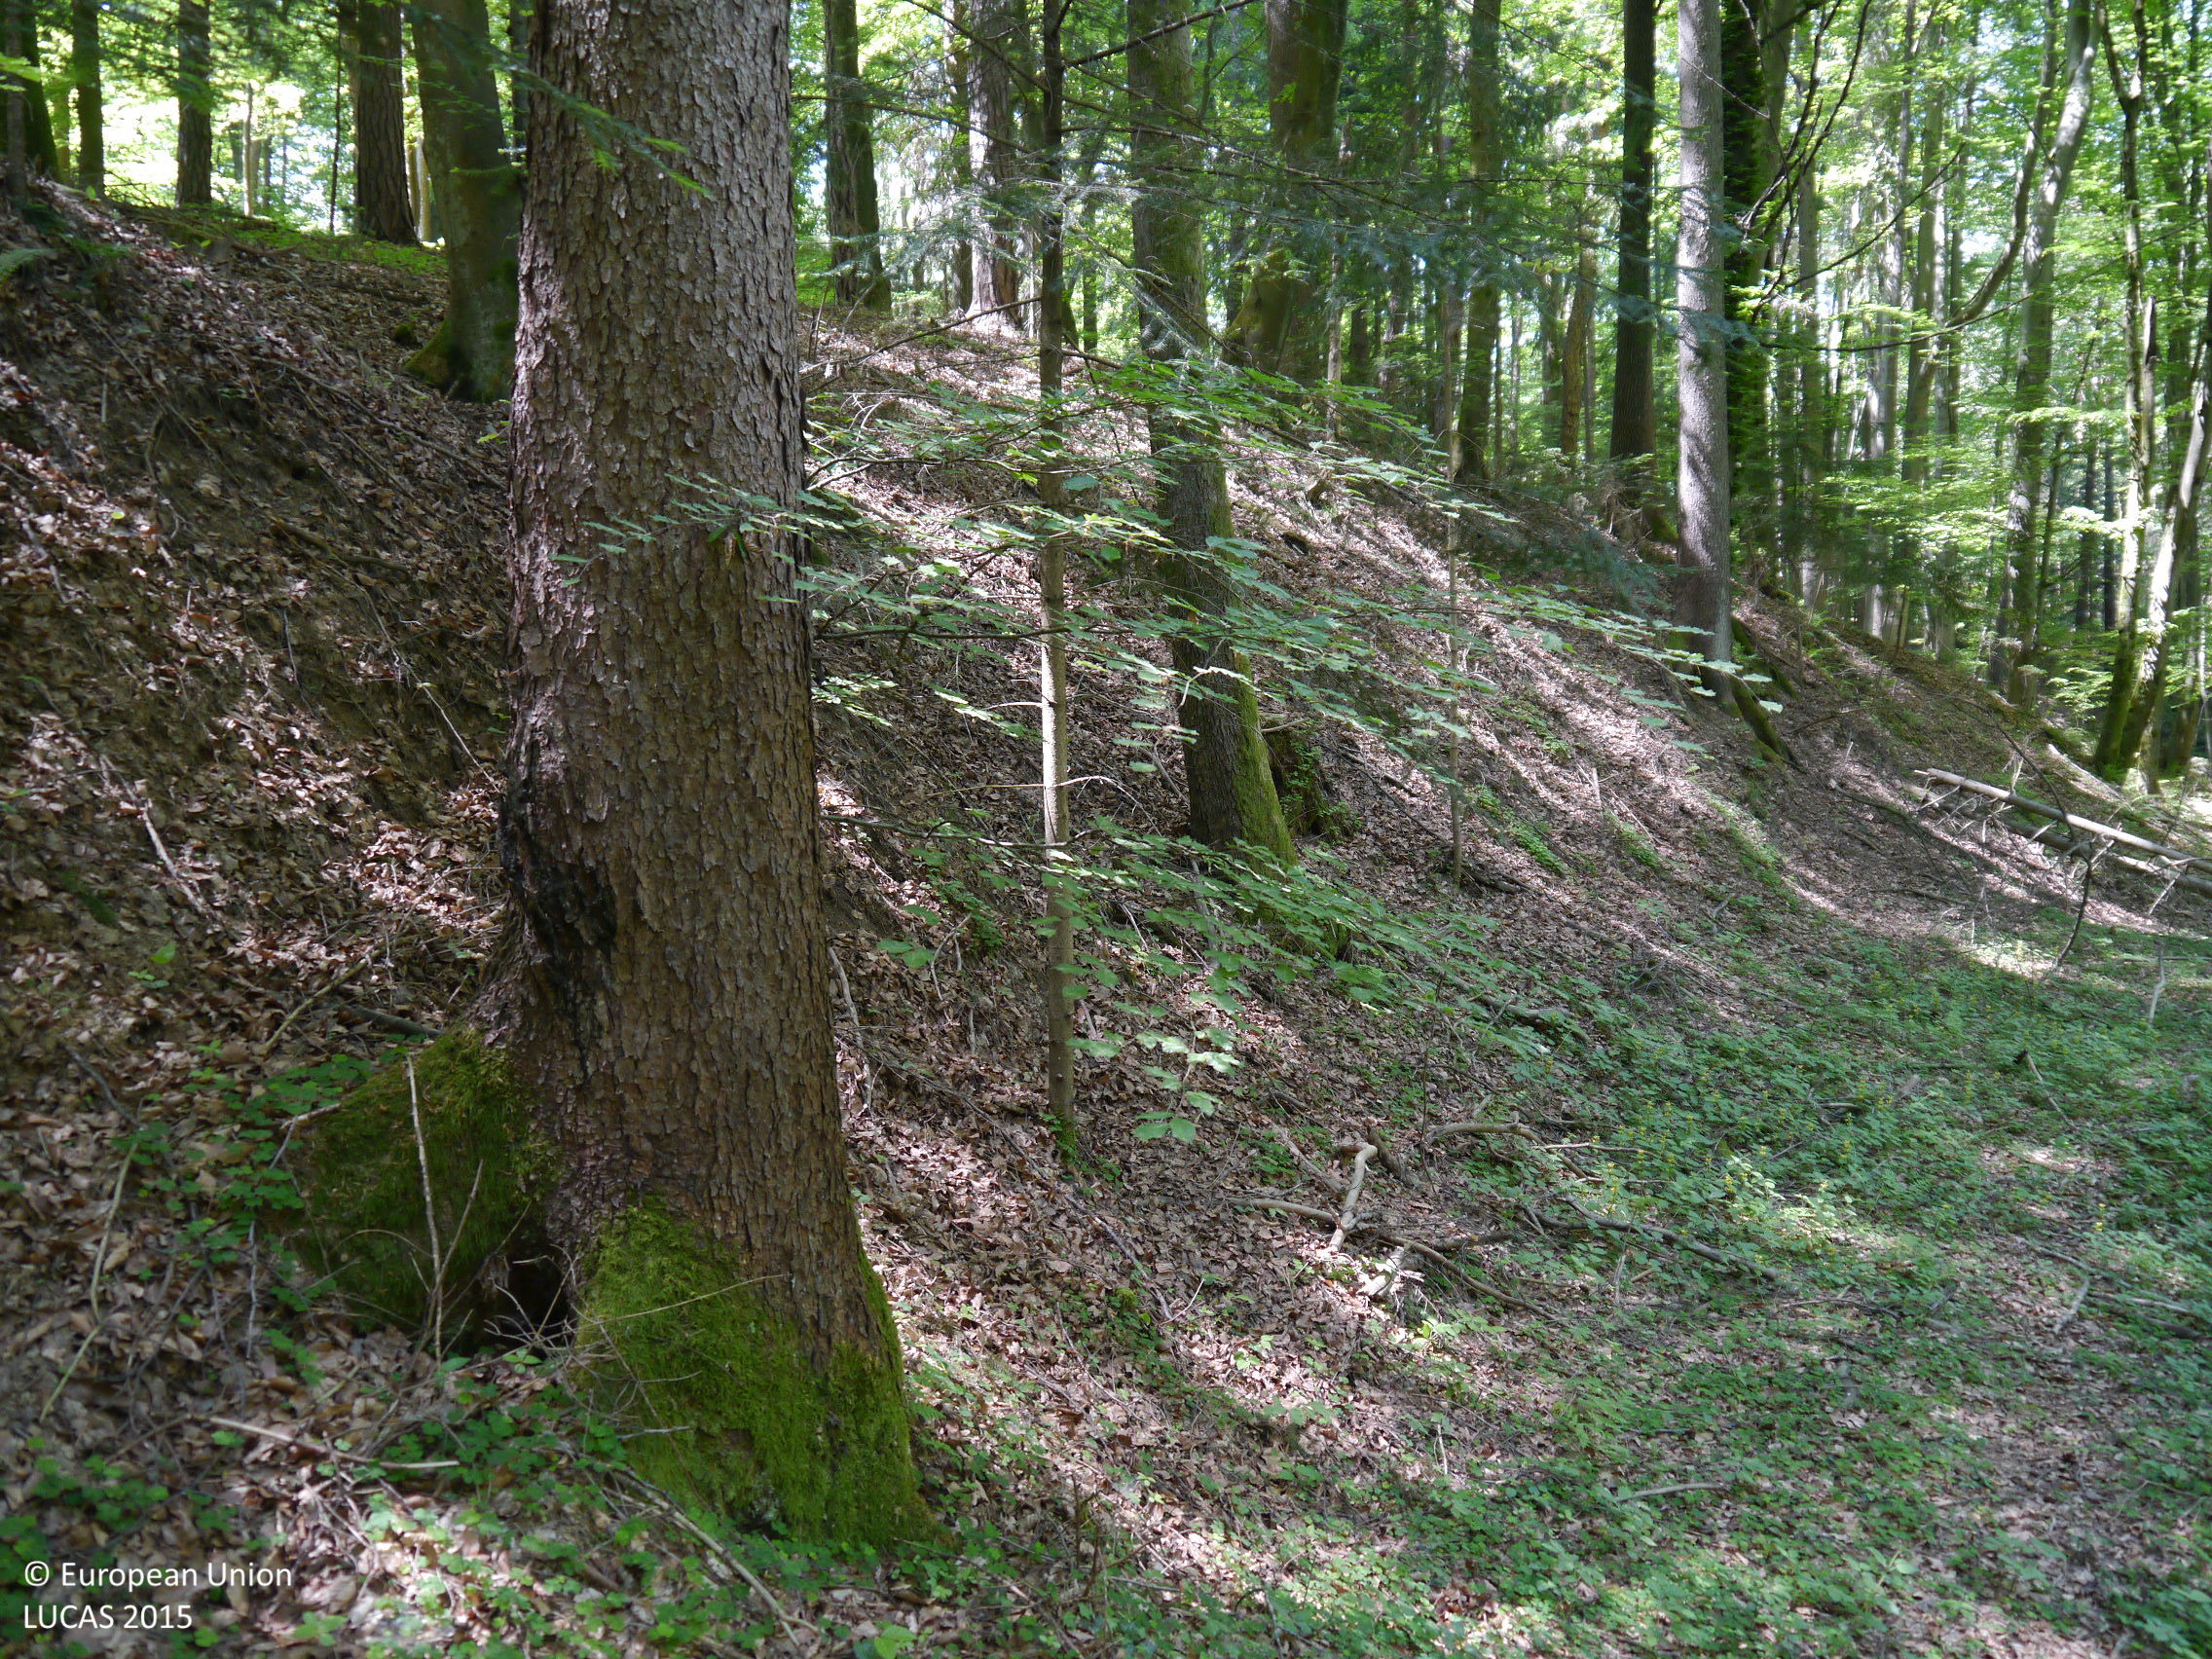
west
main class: Woodland
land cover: Spruce dominated mixed woodland
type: hemiboreal forest and nemoral coniferous forest and mixed broadleaved-coniferous forest
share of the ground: > 75 %
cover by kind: coniferous forest trees 50 %, broadleaved forest trees 40 %, herbaceous plants 10 %
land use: Forestry
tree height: > 5 m
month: May
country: AT
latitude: 46.9599
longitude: 15.2953
